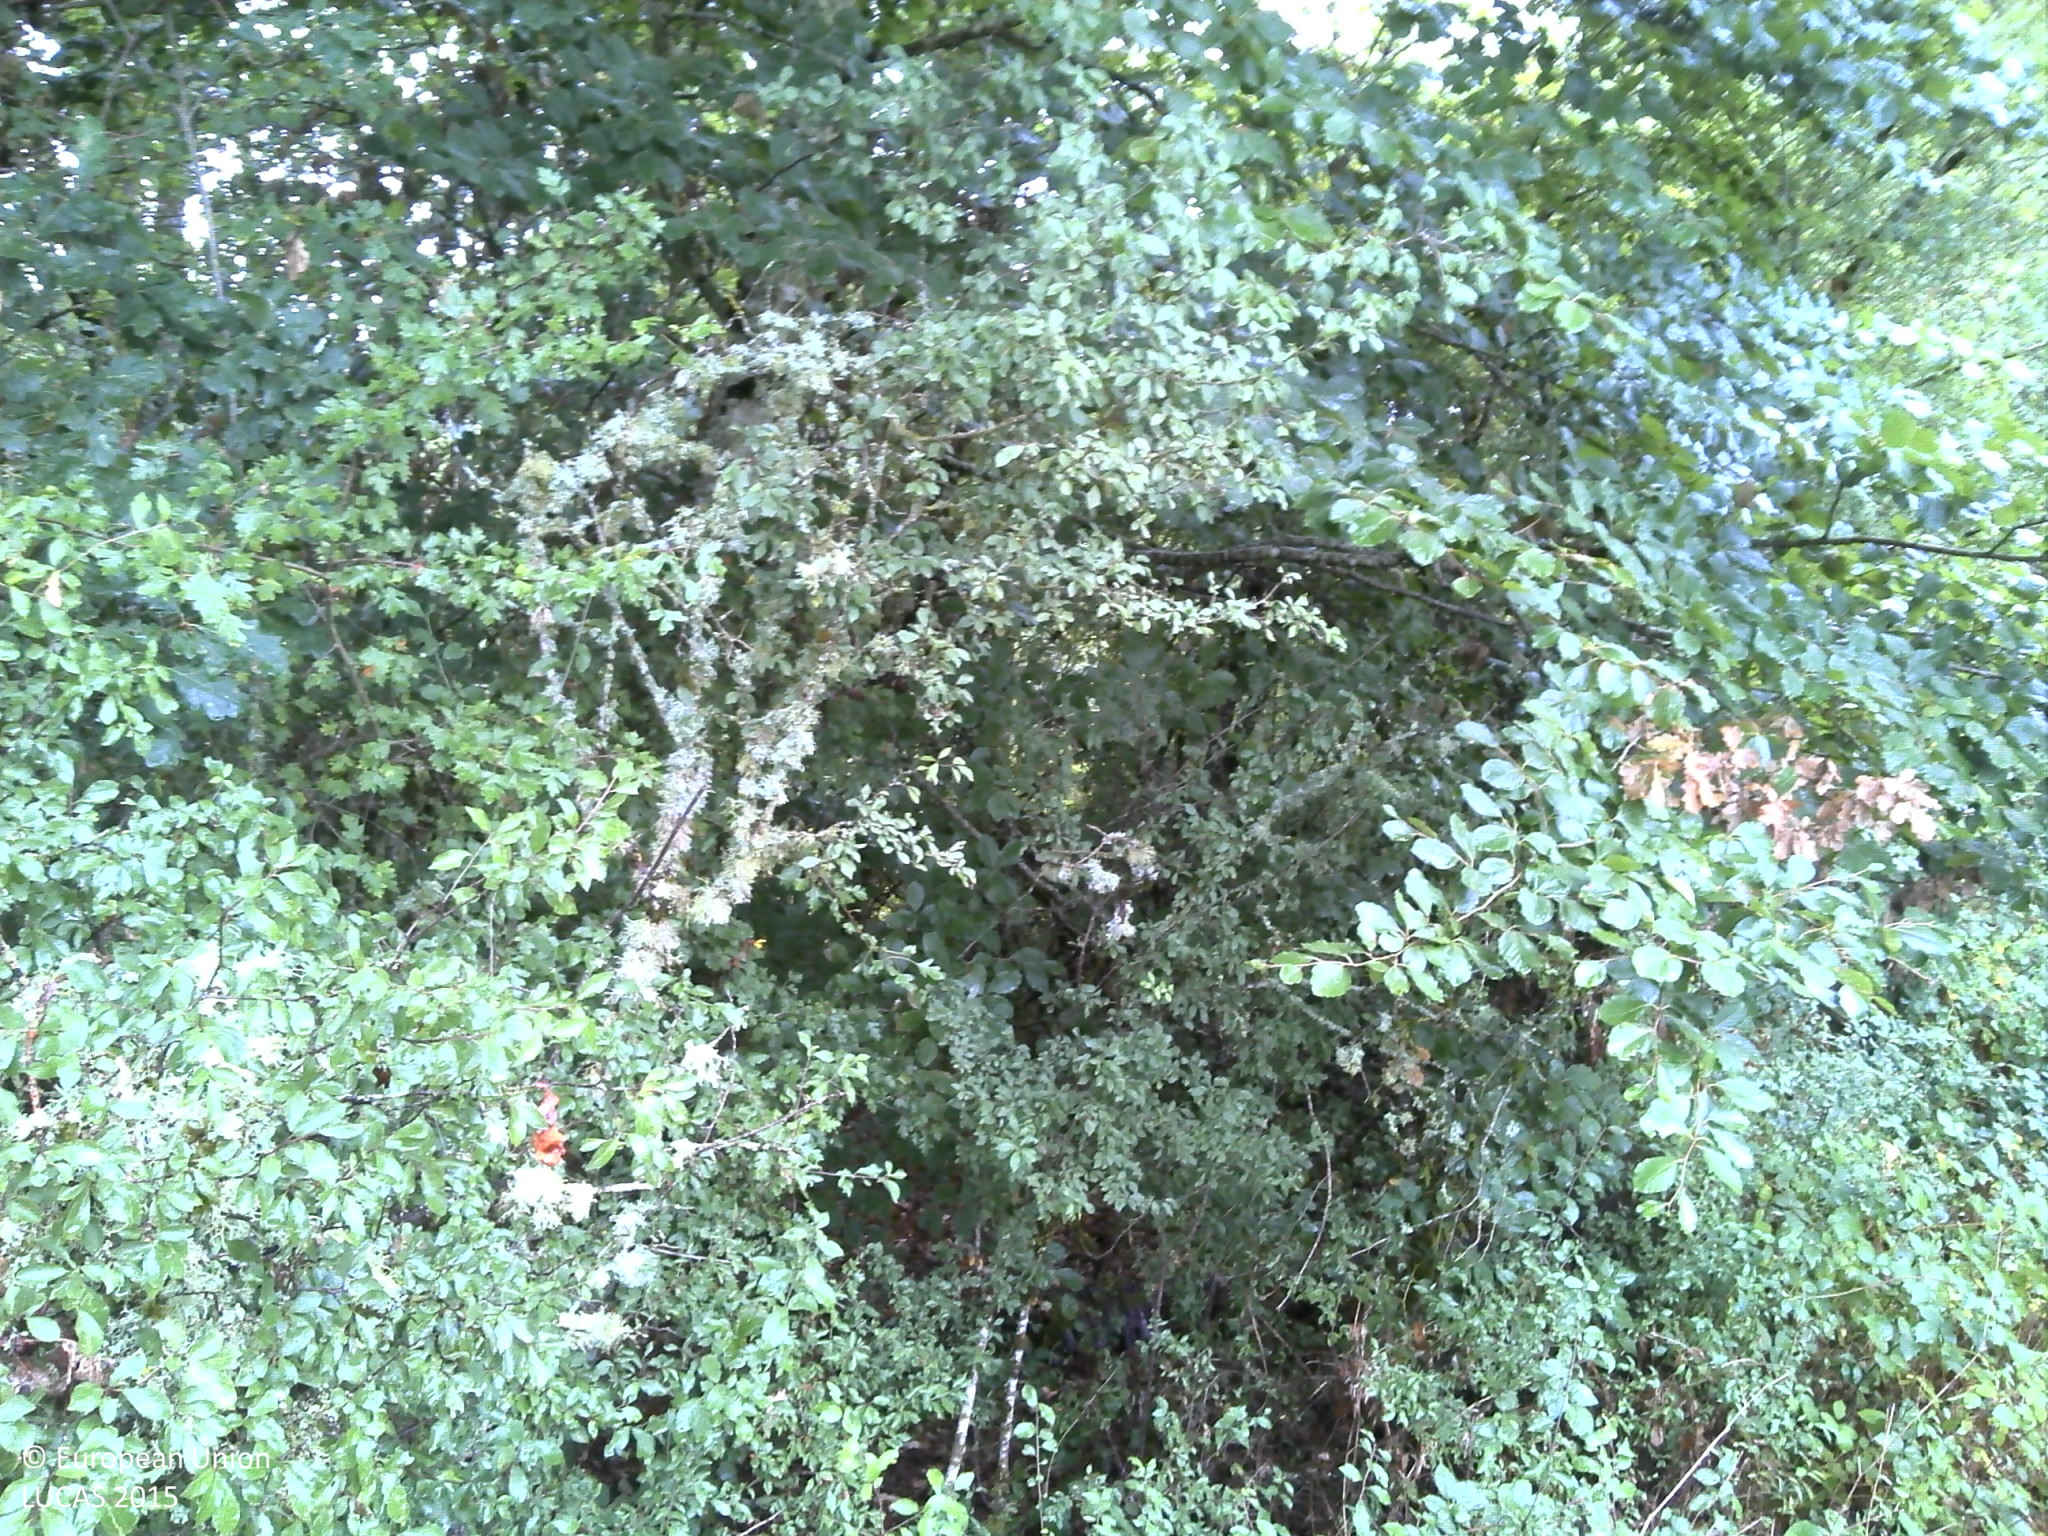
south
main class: Grassland
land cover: Grassland without tree/shrub cover
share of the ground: > 75 %
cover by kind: herbaceous plants 90 %, unconsolidated bare surface 10 %
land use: Agriculture (excluding fallow land and kitchen gardens)
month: August
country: FR
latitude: 45.4306
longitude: 2.4187
